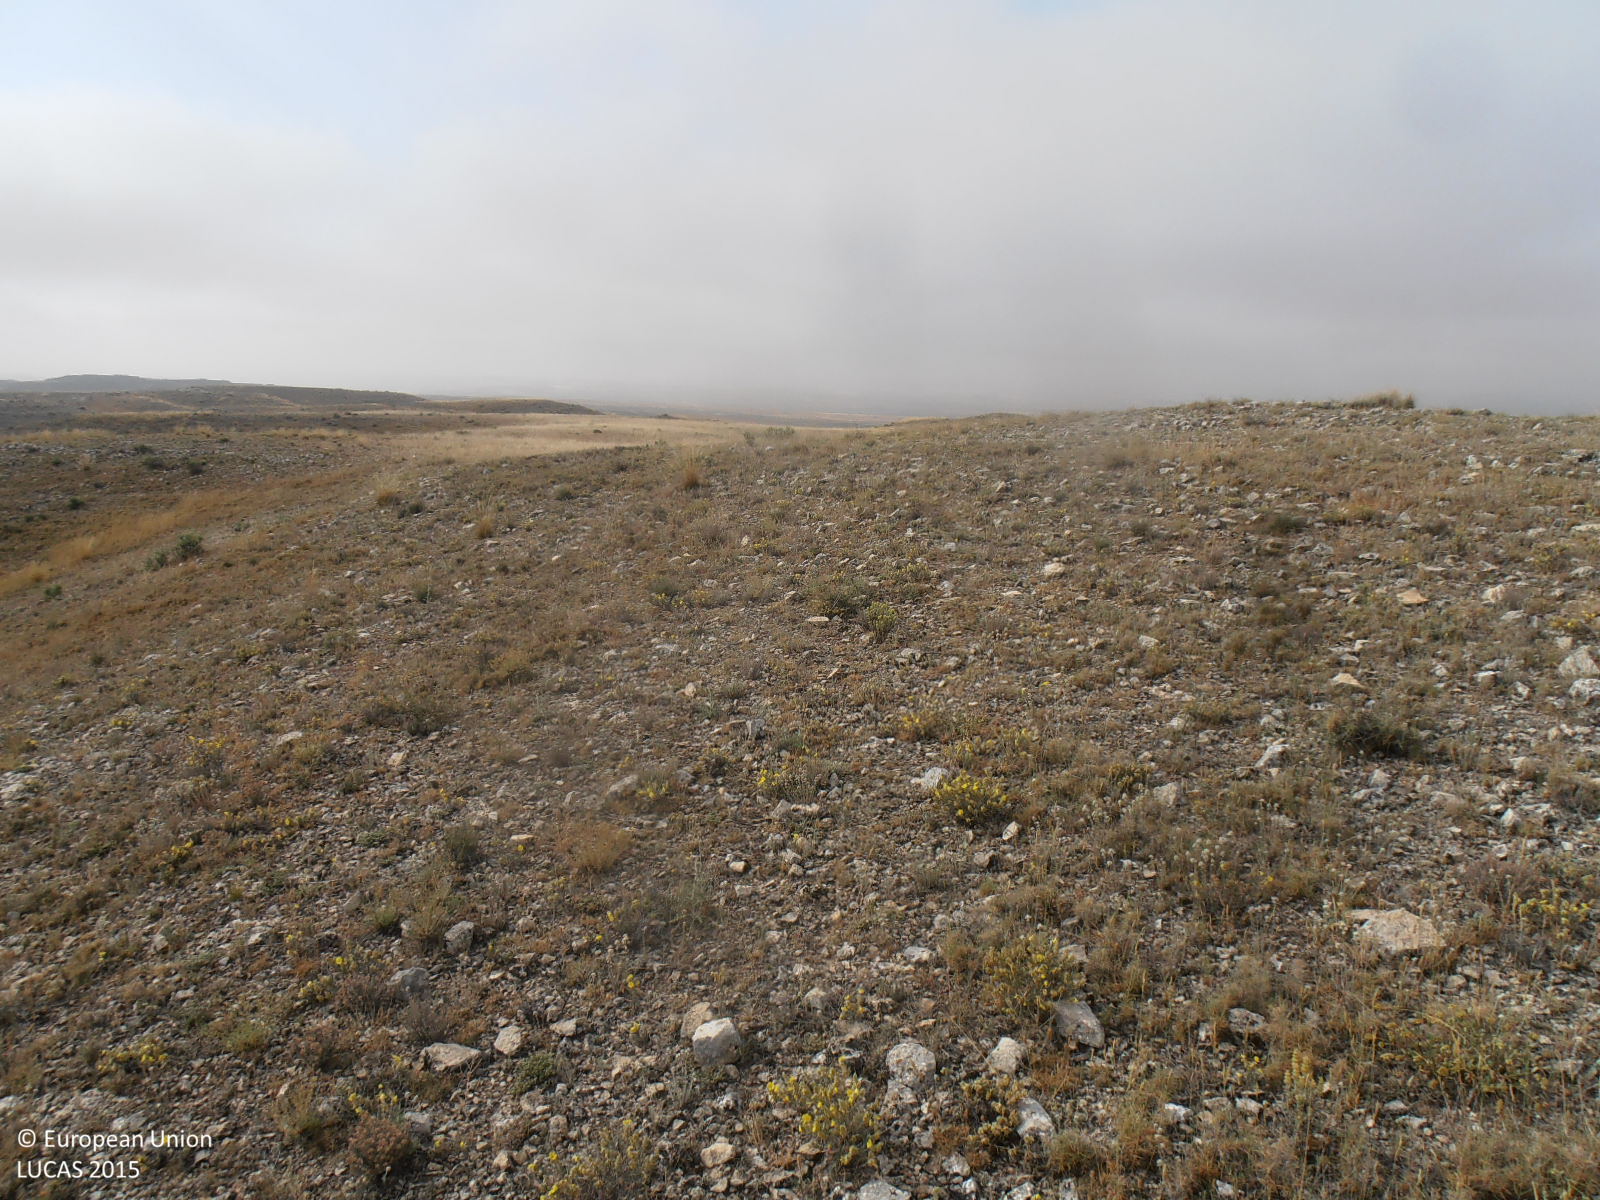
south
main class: Shrubland
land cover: Shrubland without tree cover
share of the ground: > 75 %
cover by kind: shrubs 60 %, herbaceous plants 30 %, consolidated bare surface 10 %
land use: Semi-natural and natural areas not in use
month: June
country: ES
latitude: 41.6247
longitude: -1.2468
